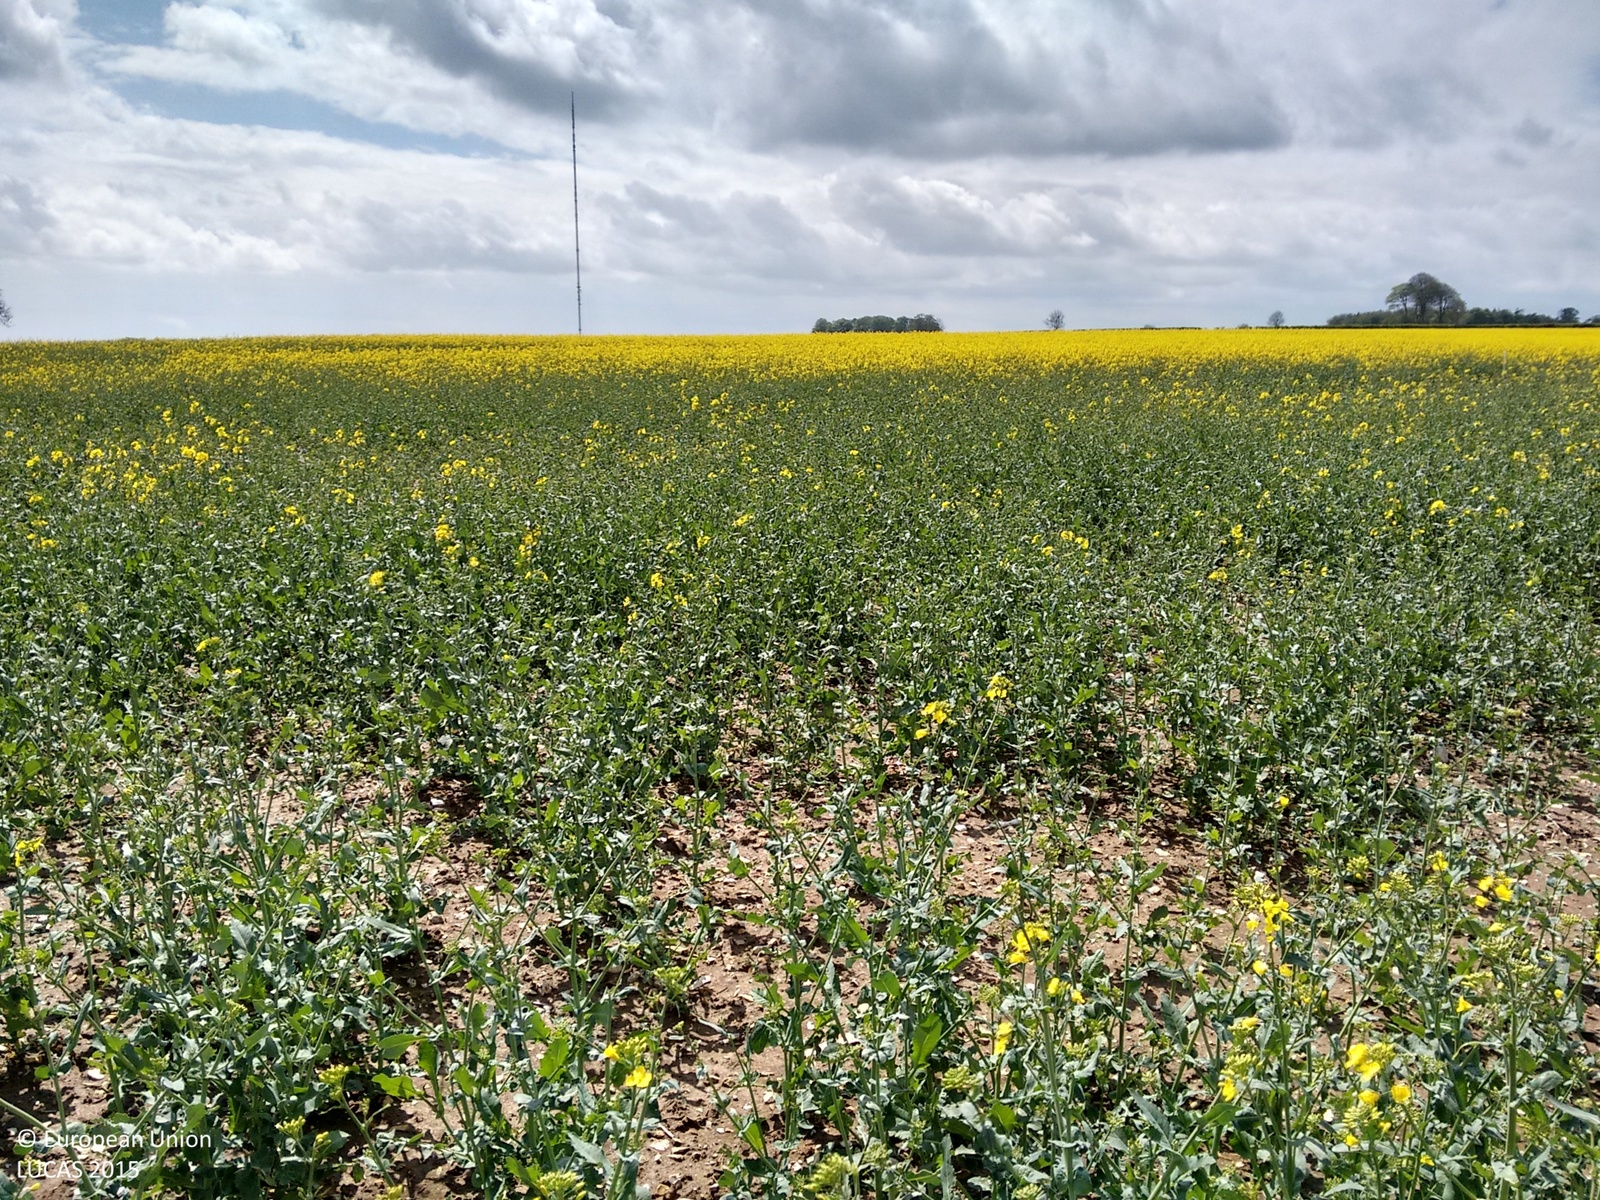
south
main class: Cropland
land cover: Rape and turnip rape
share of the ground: 50 - 75 %
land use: Agriculture (excluding fallow land and kitchen gardens)
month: May
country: GB
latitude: 53.3529
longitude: -0.1746
